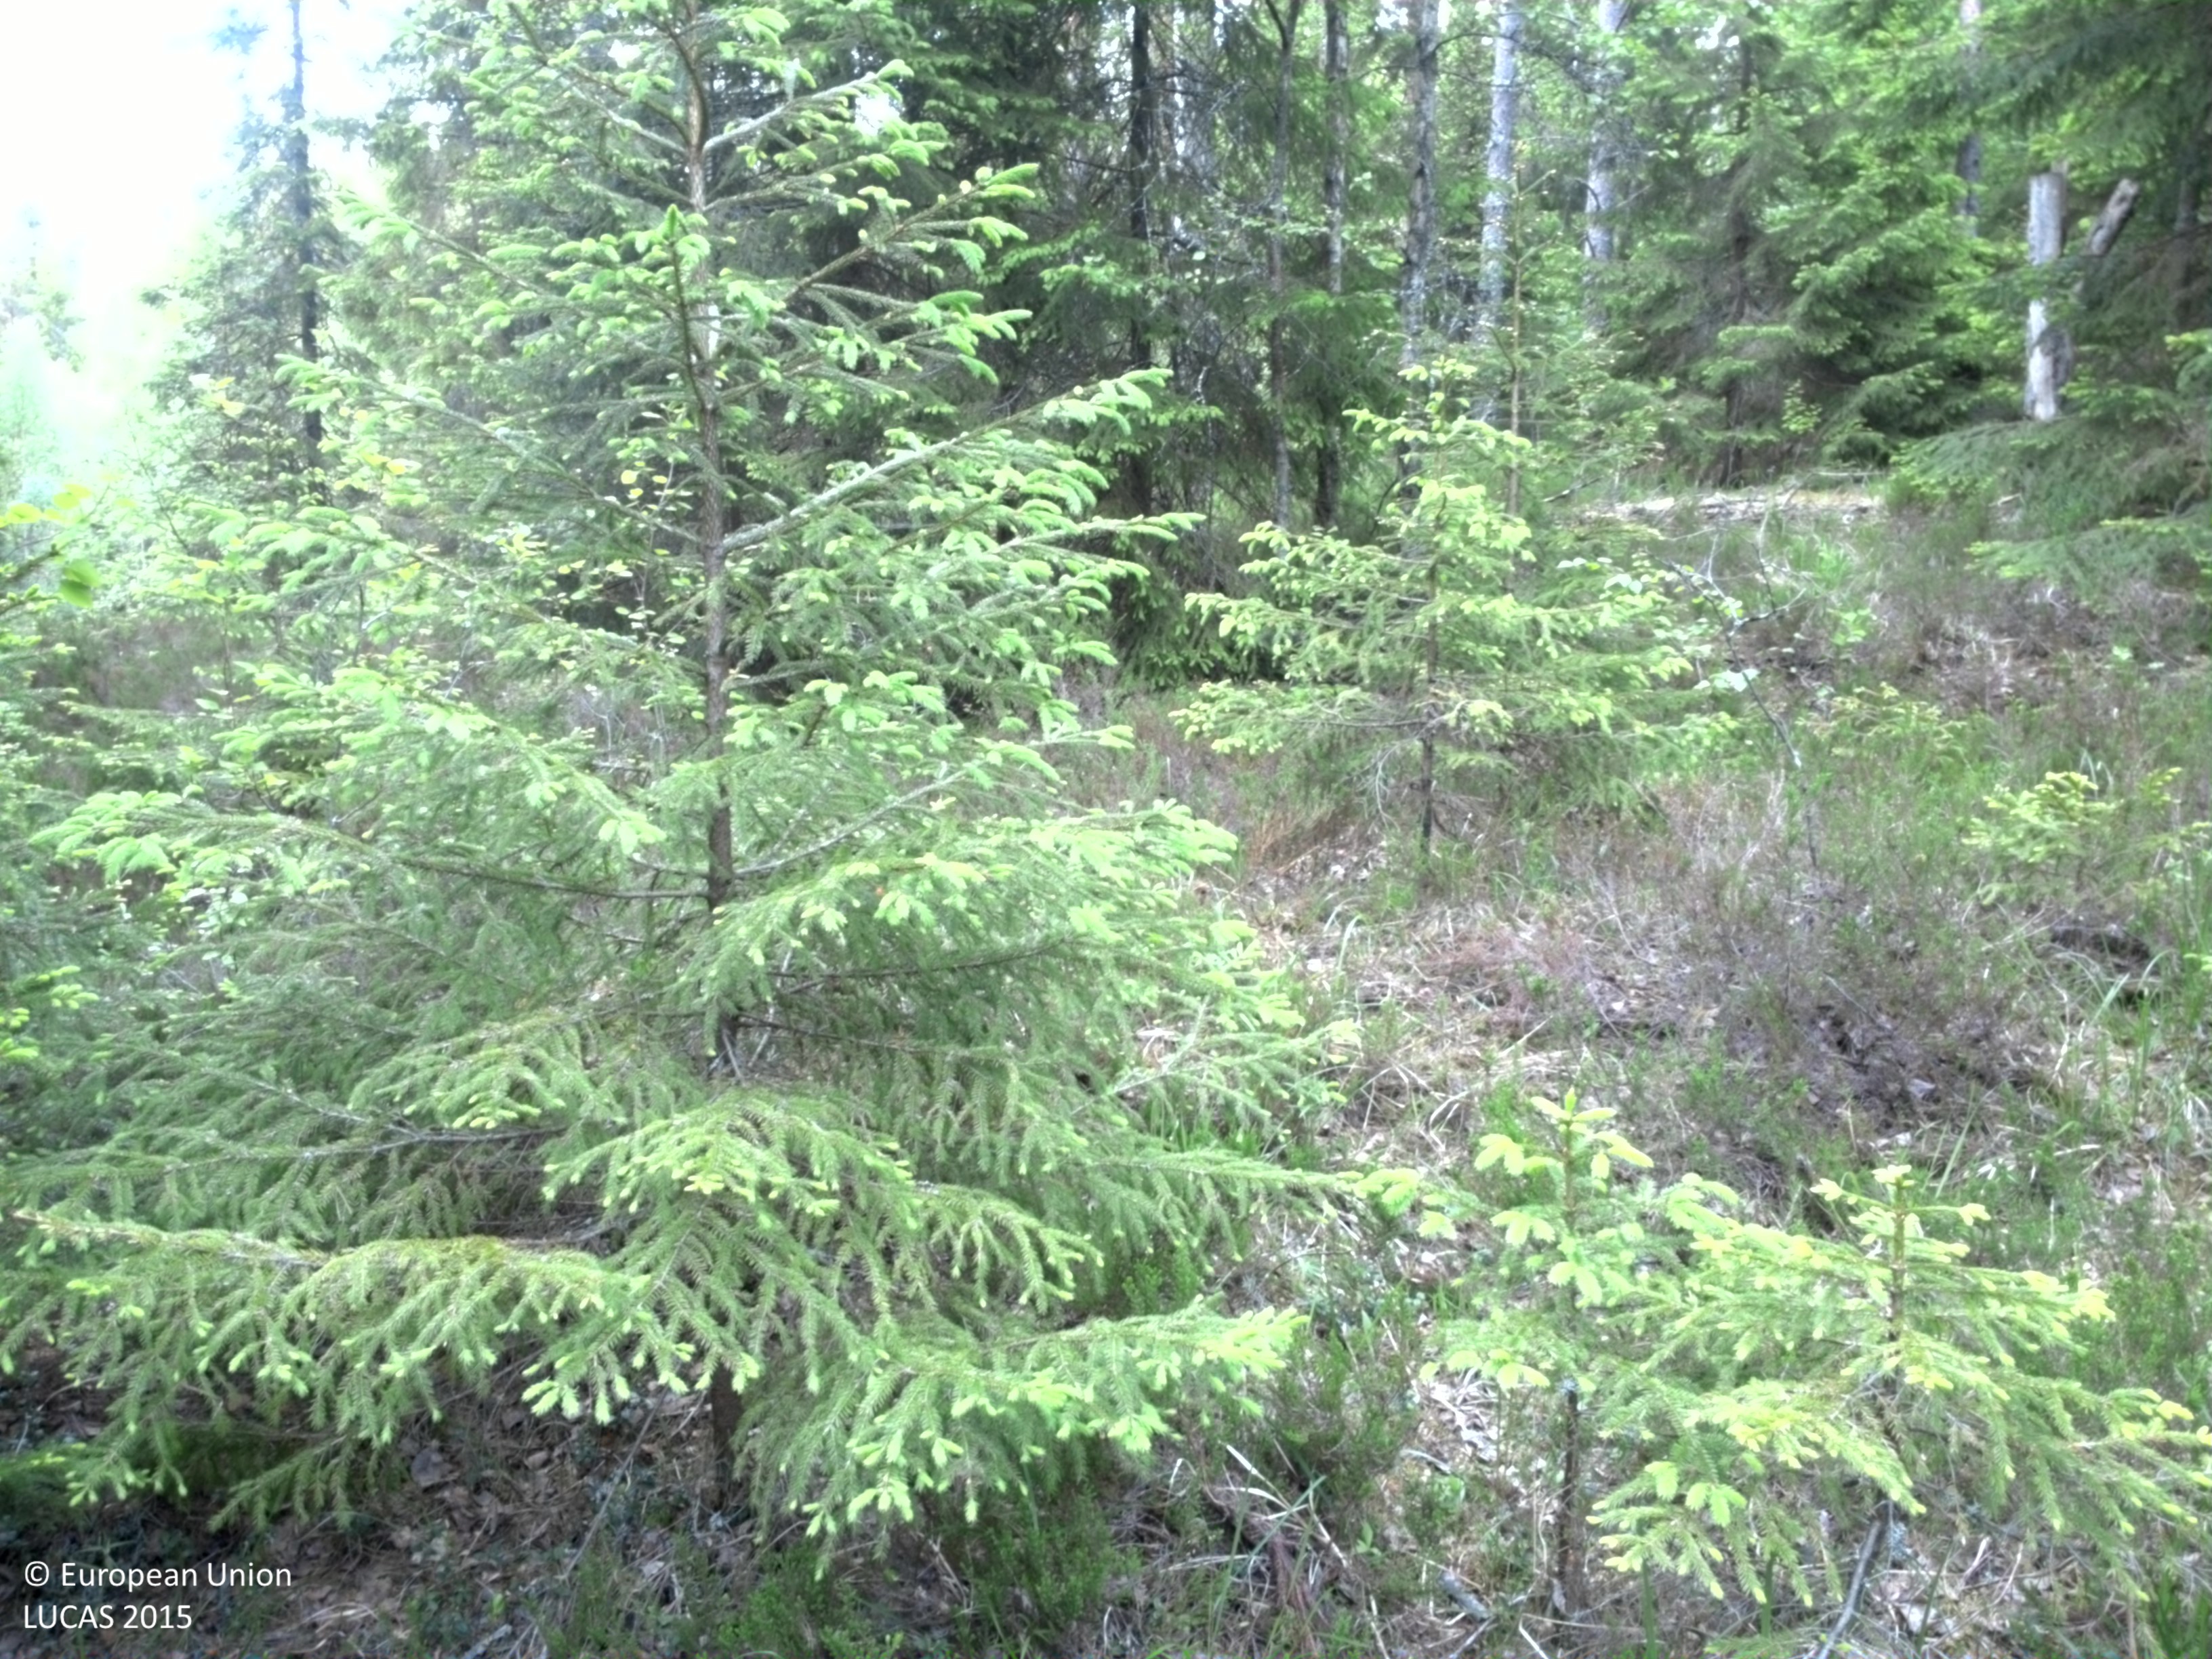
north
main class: Woodland
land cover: Other mixed woodland
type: boreal forest
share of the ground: 50 - 75 %
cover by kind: coniferous forest trees 40 %, broadleaved forest trees 30 %, shrubs 20 %, herbaceous plants 10 %
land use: Forestry
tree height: > 5 m
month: June
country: SE
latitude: 59.6431
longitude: 14.4078
